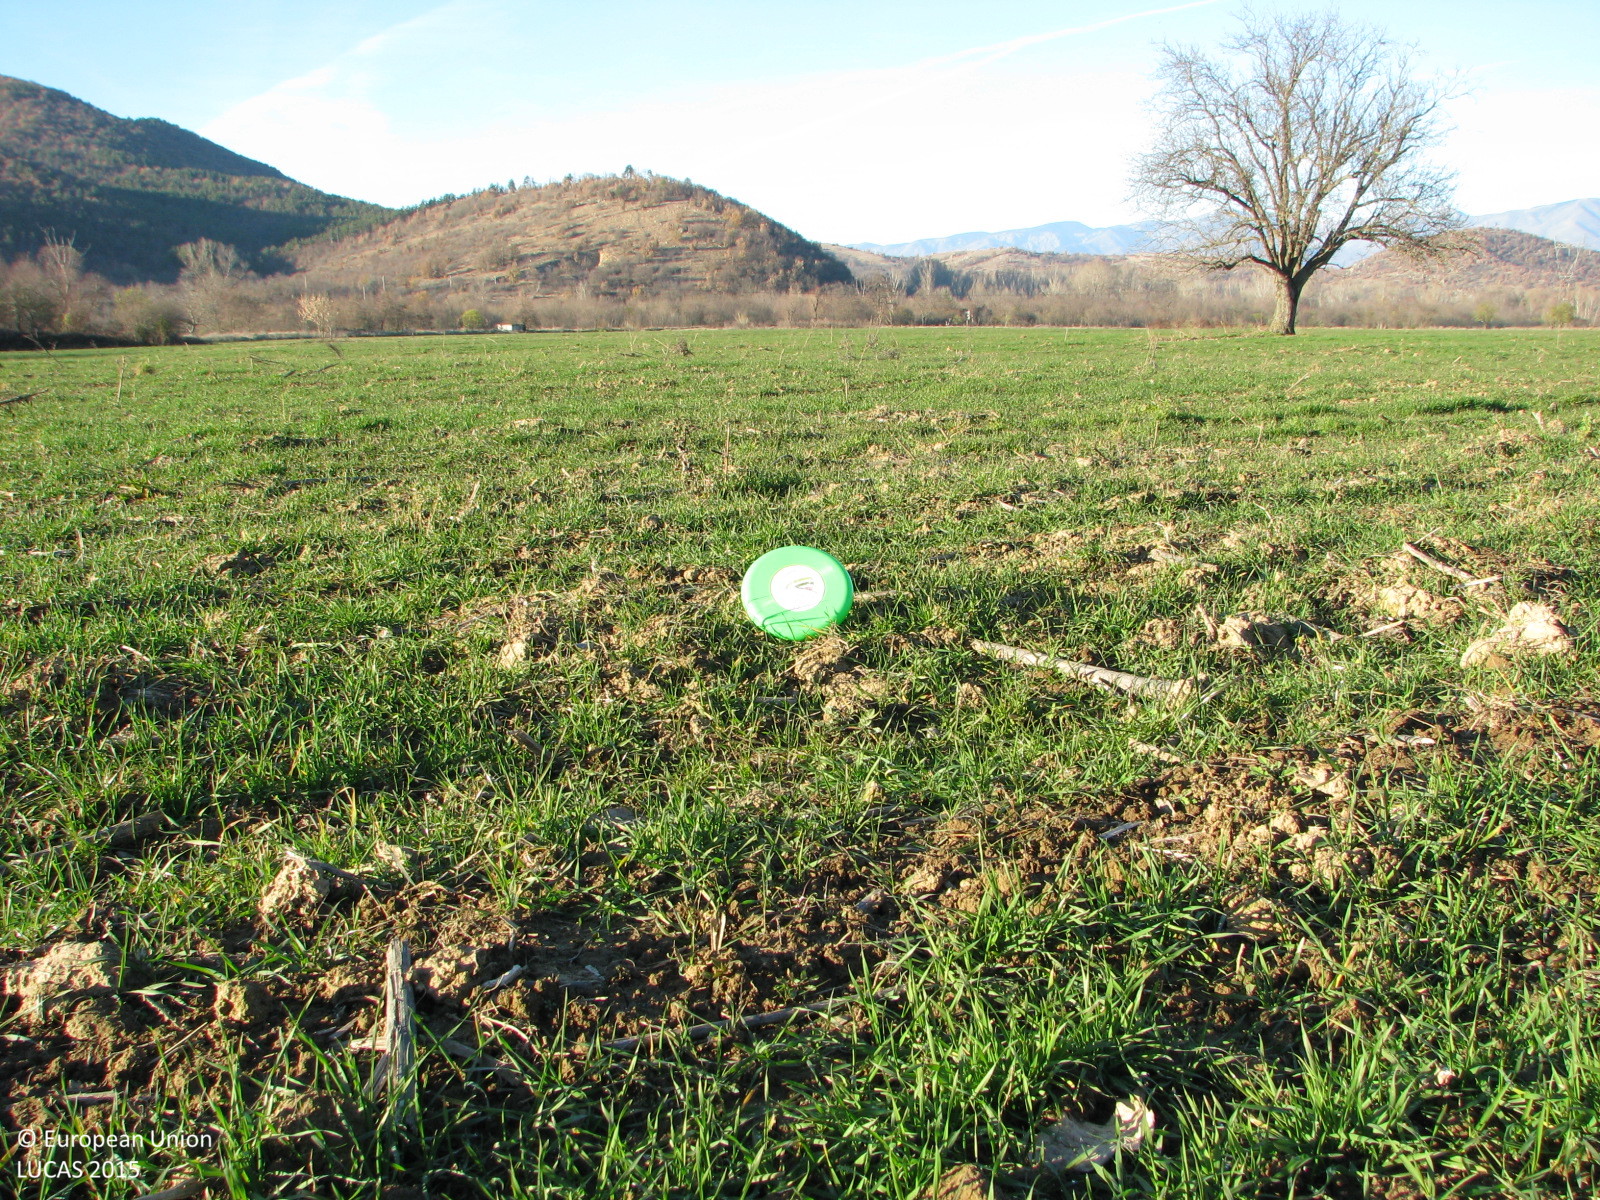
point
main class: Cropland
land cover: Common wheat
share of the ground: > 75 %
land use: Agriculture (excluding fallow land and kitchen gardens)
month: December
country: BG
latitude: 42.4888
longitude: 24.8392
